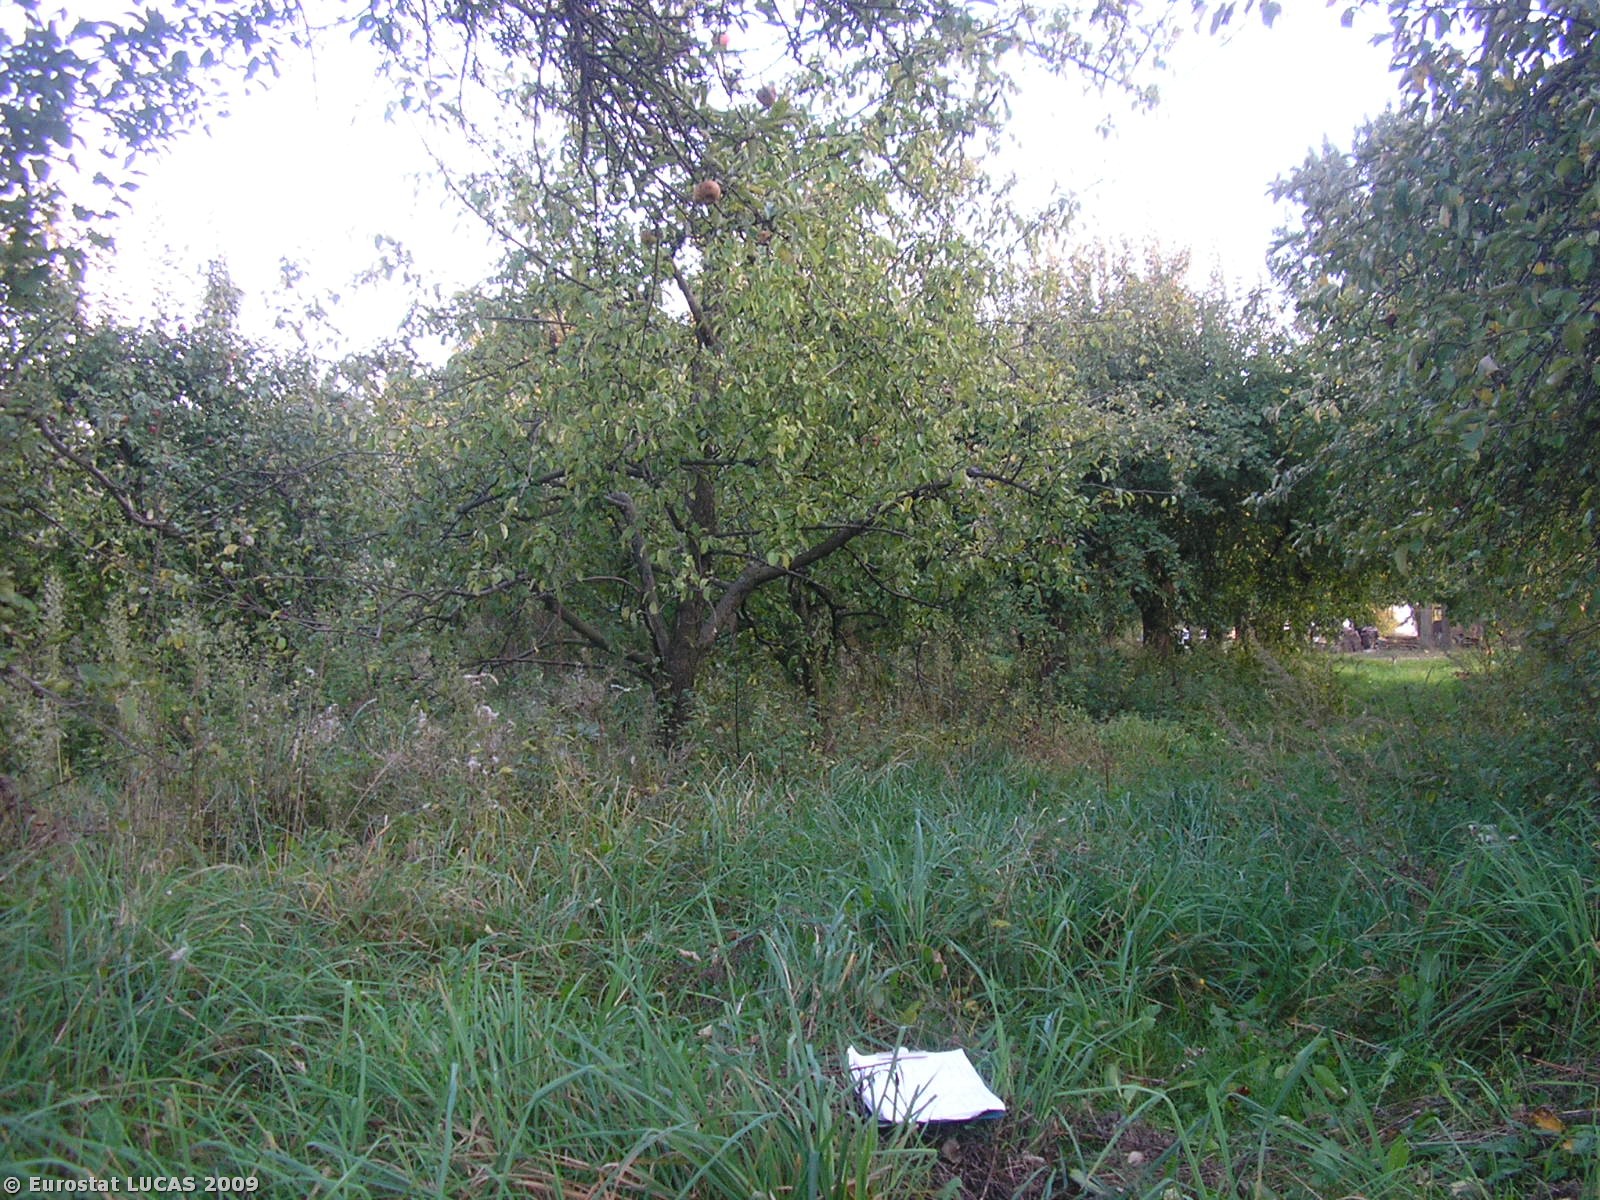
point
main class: Cropland
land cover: Apple fruit
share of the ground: 50 - 75 %
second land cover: Grassland with sparse tree/shrub cover
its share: > 75 %
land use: Agriculture (excluding fallow land and kitchen gardens)
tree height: < 5 m
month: September
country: PL
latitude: 51.8780
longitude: 20.6589
